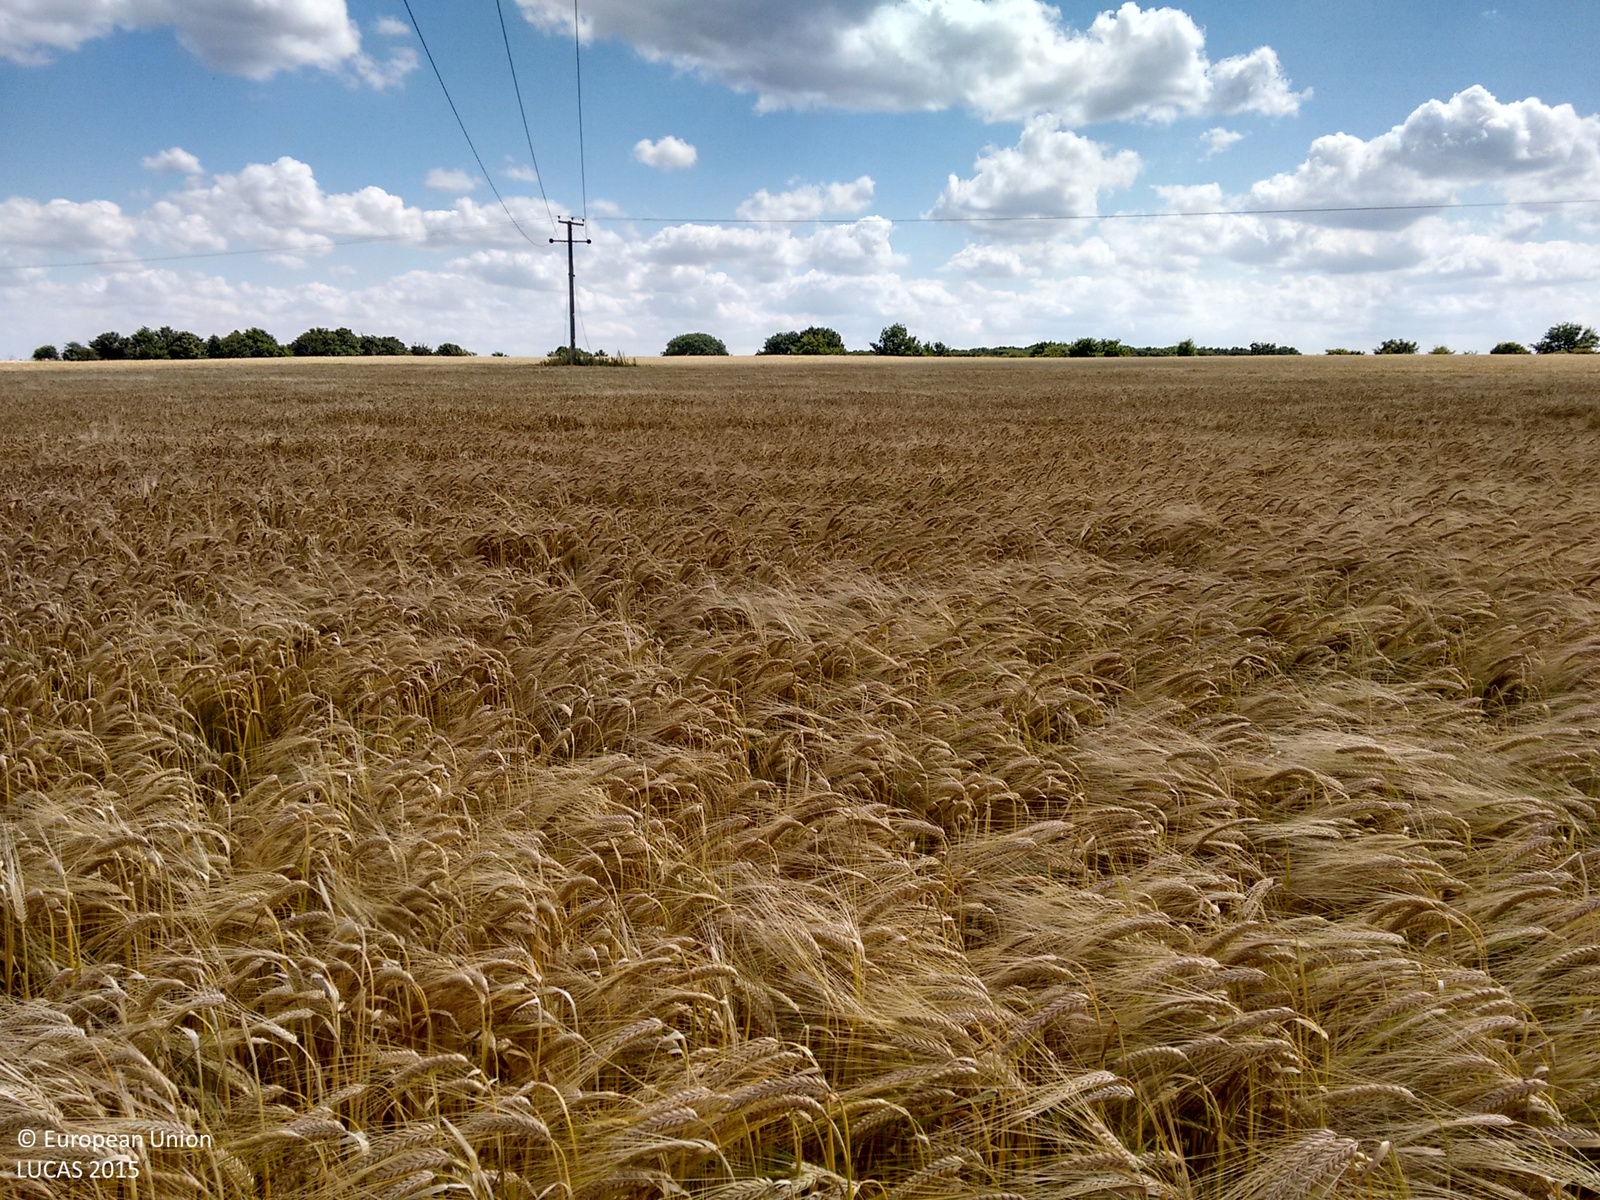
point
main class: Cropland
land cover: Barley
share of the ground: > 75 %
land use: Agriculture (excluding fallow land and kitchen gardens)
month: July
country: GB
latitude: 52.7316
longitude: 0.4201
